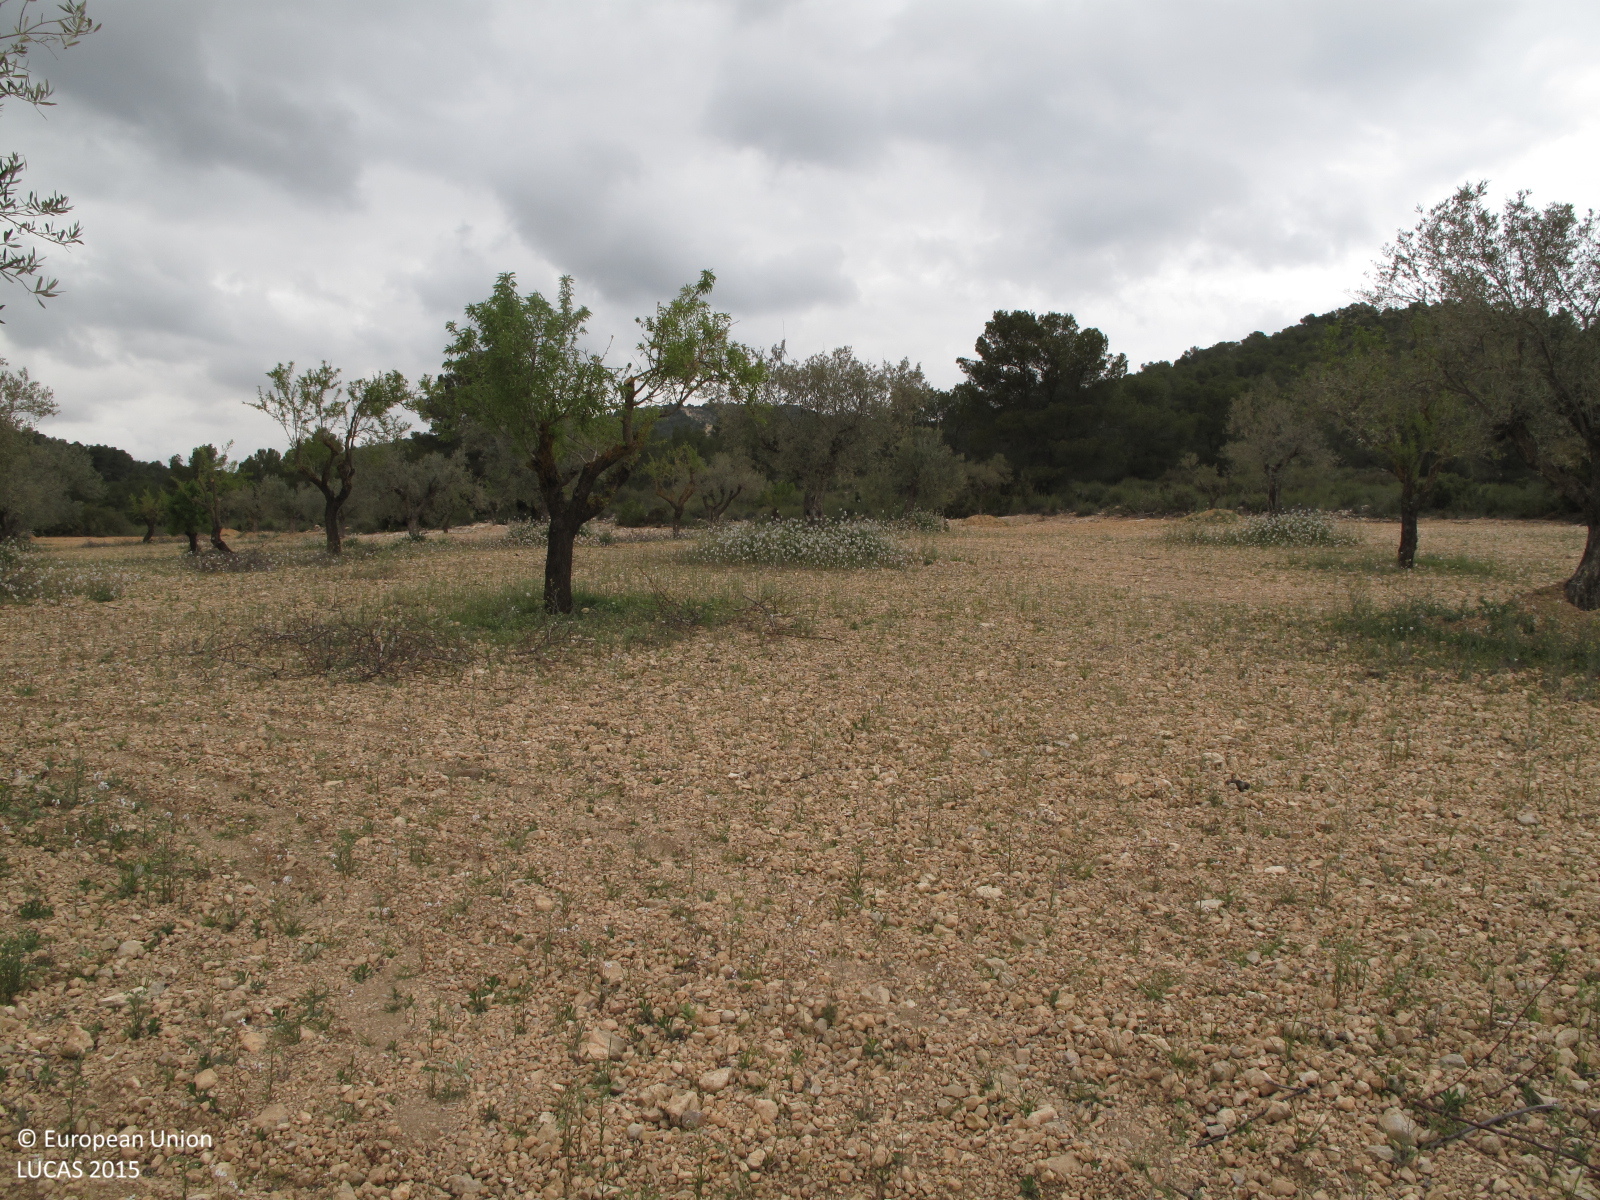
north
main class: Cropland
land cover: Olive groves
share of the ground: 25 - 50 %
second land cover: Nuts trees
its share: 25 - 50 %
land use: Agriculture (excluding fallow land and kitchen gardens)
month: April
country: ES
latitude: 38.7724
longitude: -0.9844
